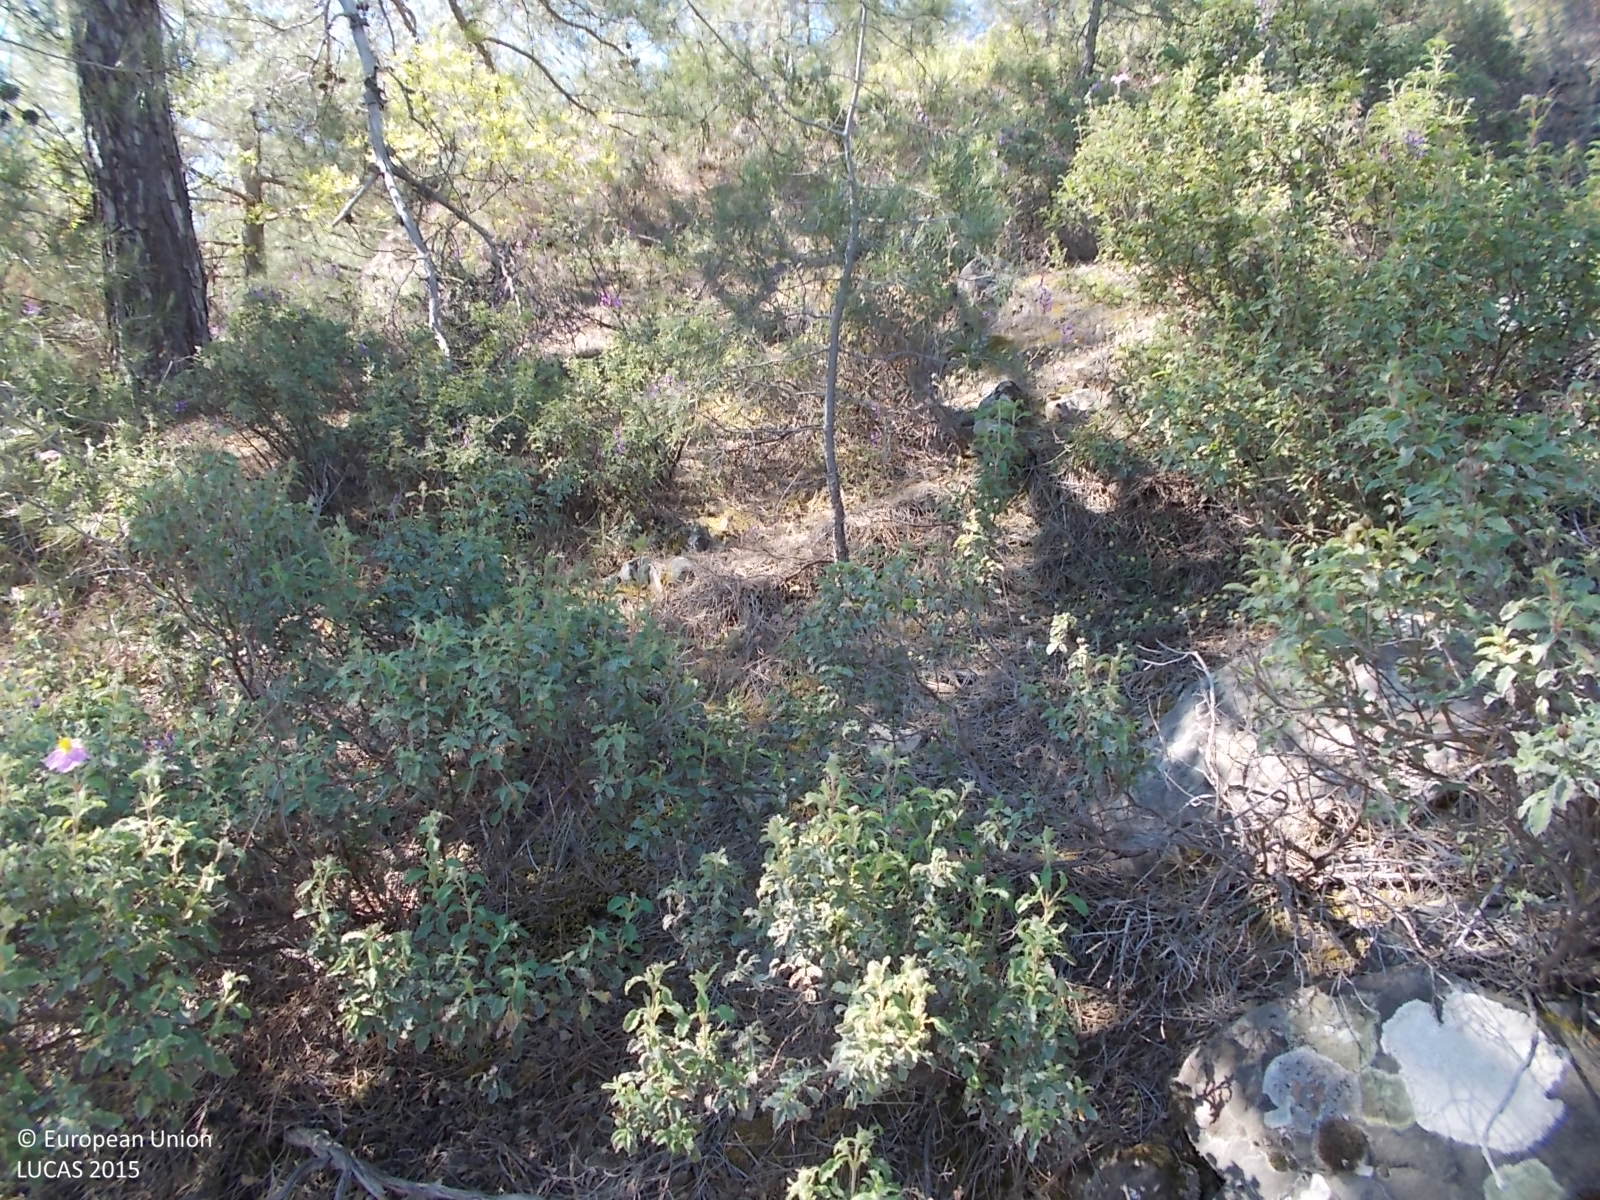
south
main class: Woodland
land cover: Pine dominated coniferous woodland
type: coniferous forest of the mediterranean region
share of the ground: > 75 %
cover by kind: coniferous forest trees 100 %
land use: Semi-natural and natural areas not in use
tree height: > 5 m
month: May
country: CY
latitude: 34.9395
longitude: 33.0910
